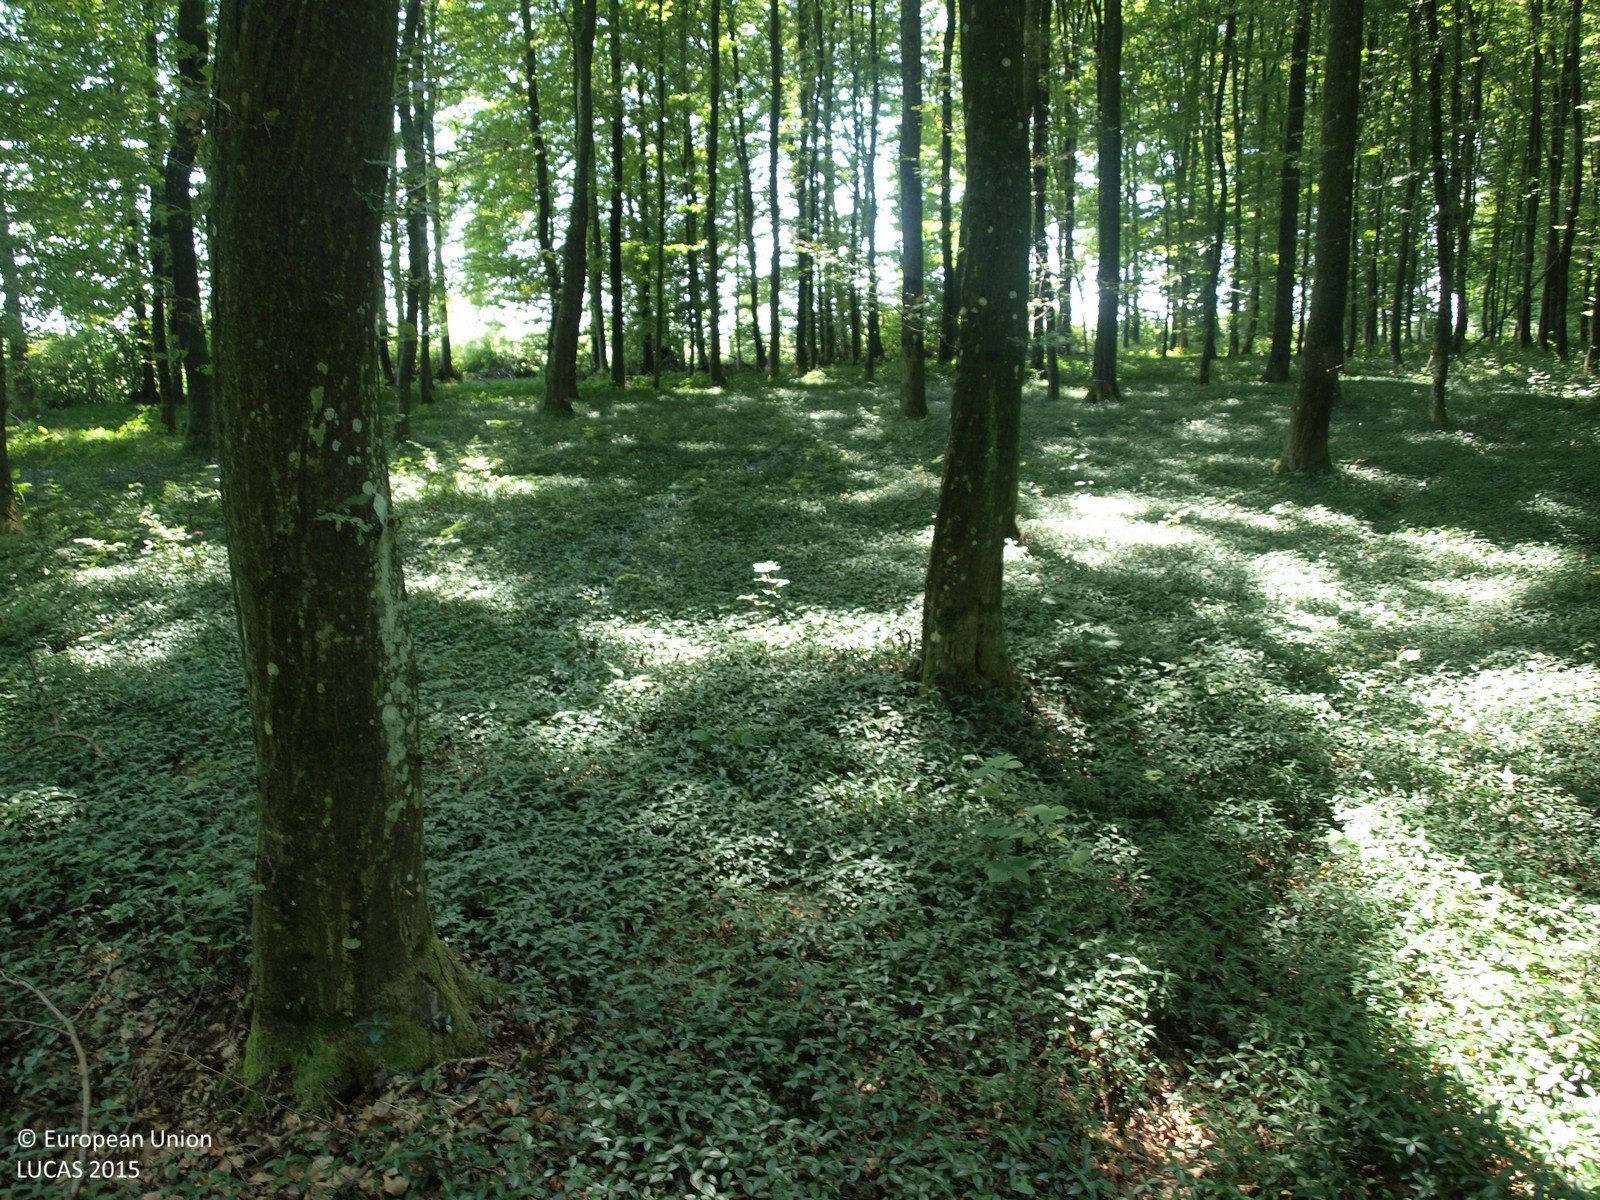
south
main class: Woodland
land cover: Broadleaved woodland
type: mesophytic deciduous forest
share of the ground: > 75 %
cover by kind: broadleaved forest trees 100 %
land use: Forestry
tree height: > 5 m
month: August
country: HR
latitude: 45.8757
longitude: 16.6090
